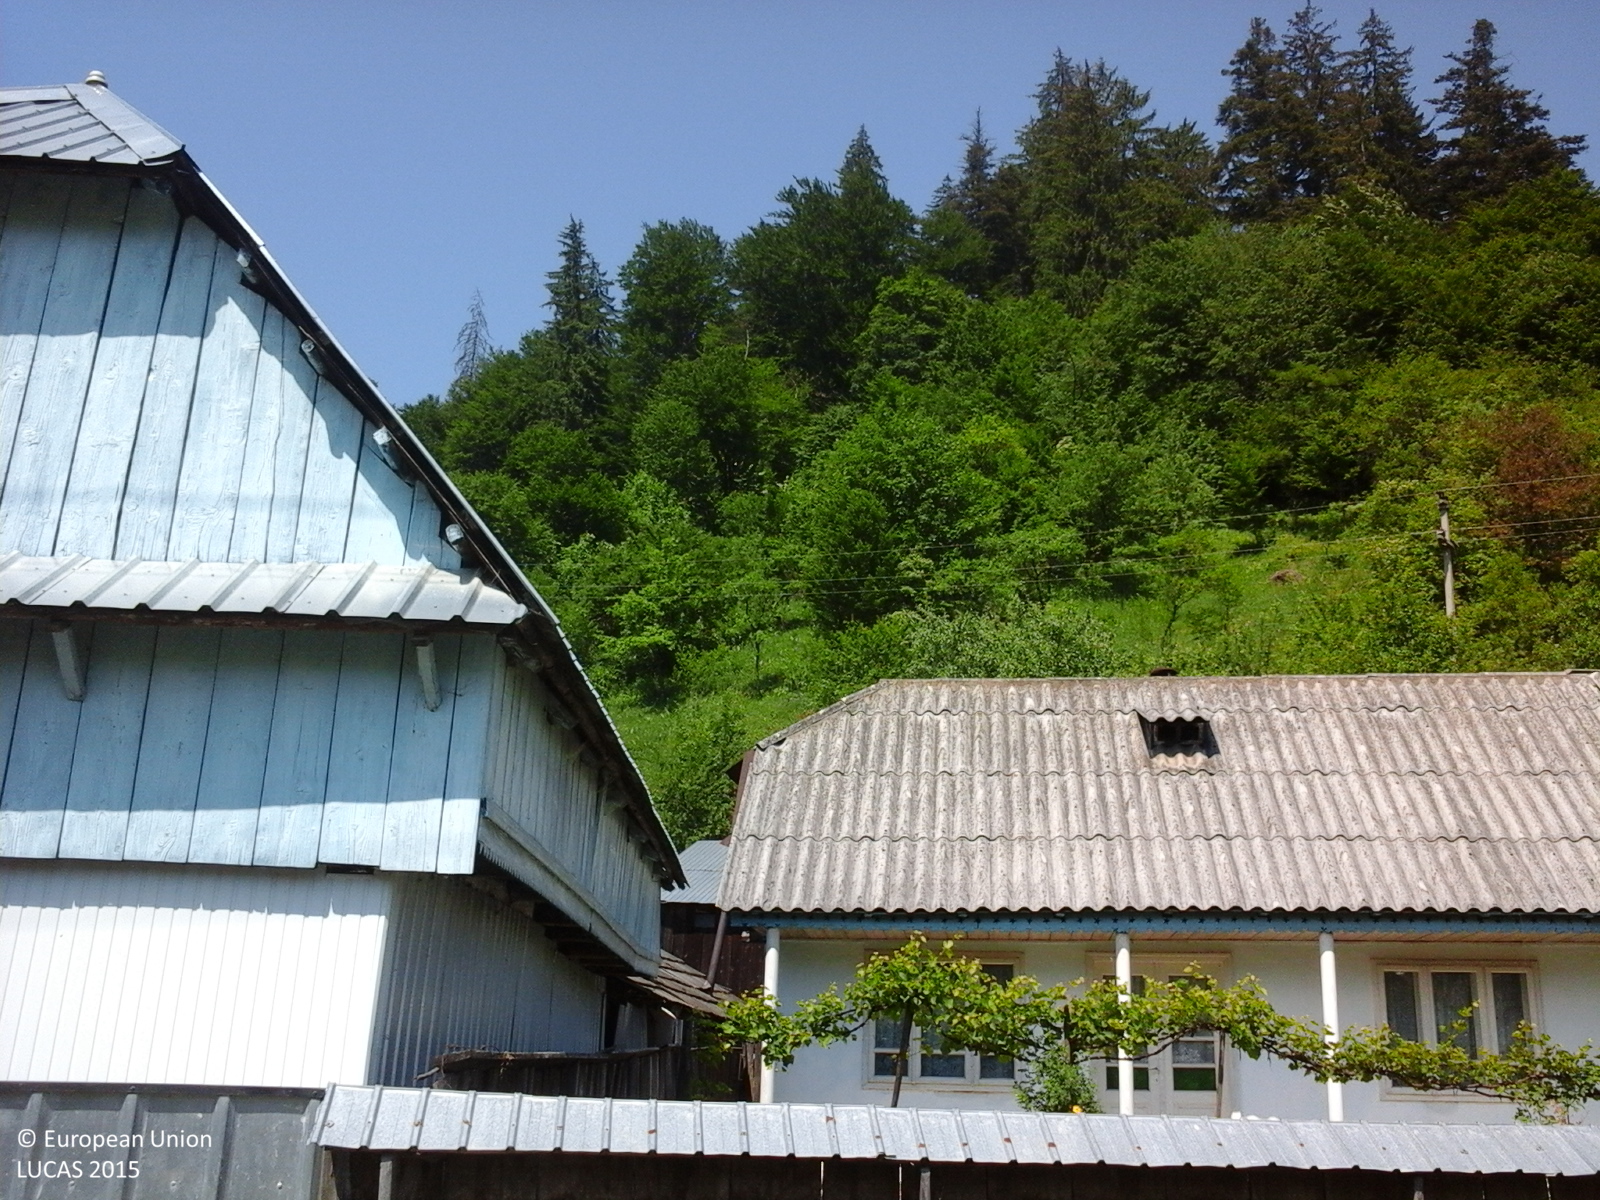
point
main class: Woodland
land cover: Other mixed woodland
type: beech forest
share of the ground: > 75 %
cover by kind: broadleaved forest trees 70 %, coniferous forest trees 30 %
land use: Forestry
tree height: > 5 m
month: June
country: RO
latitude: 46.6376
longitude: 26.5035
